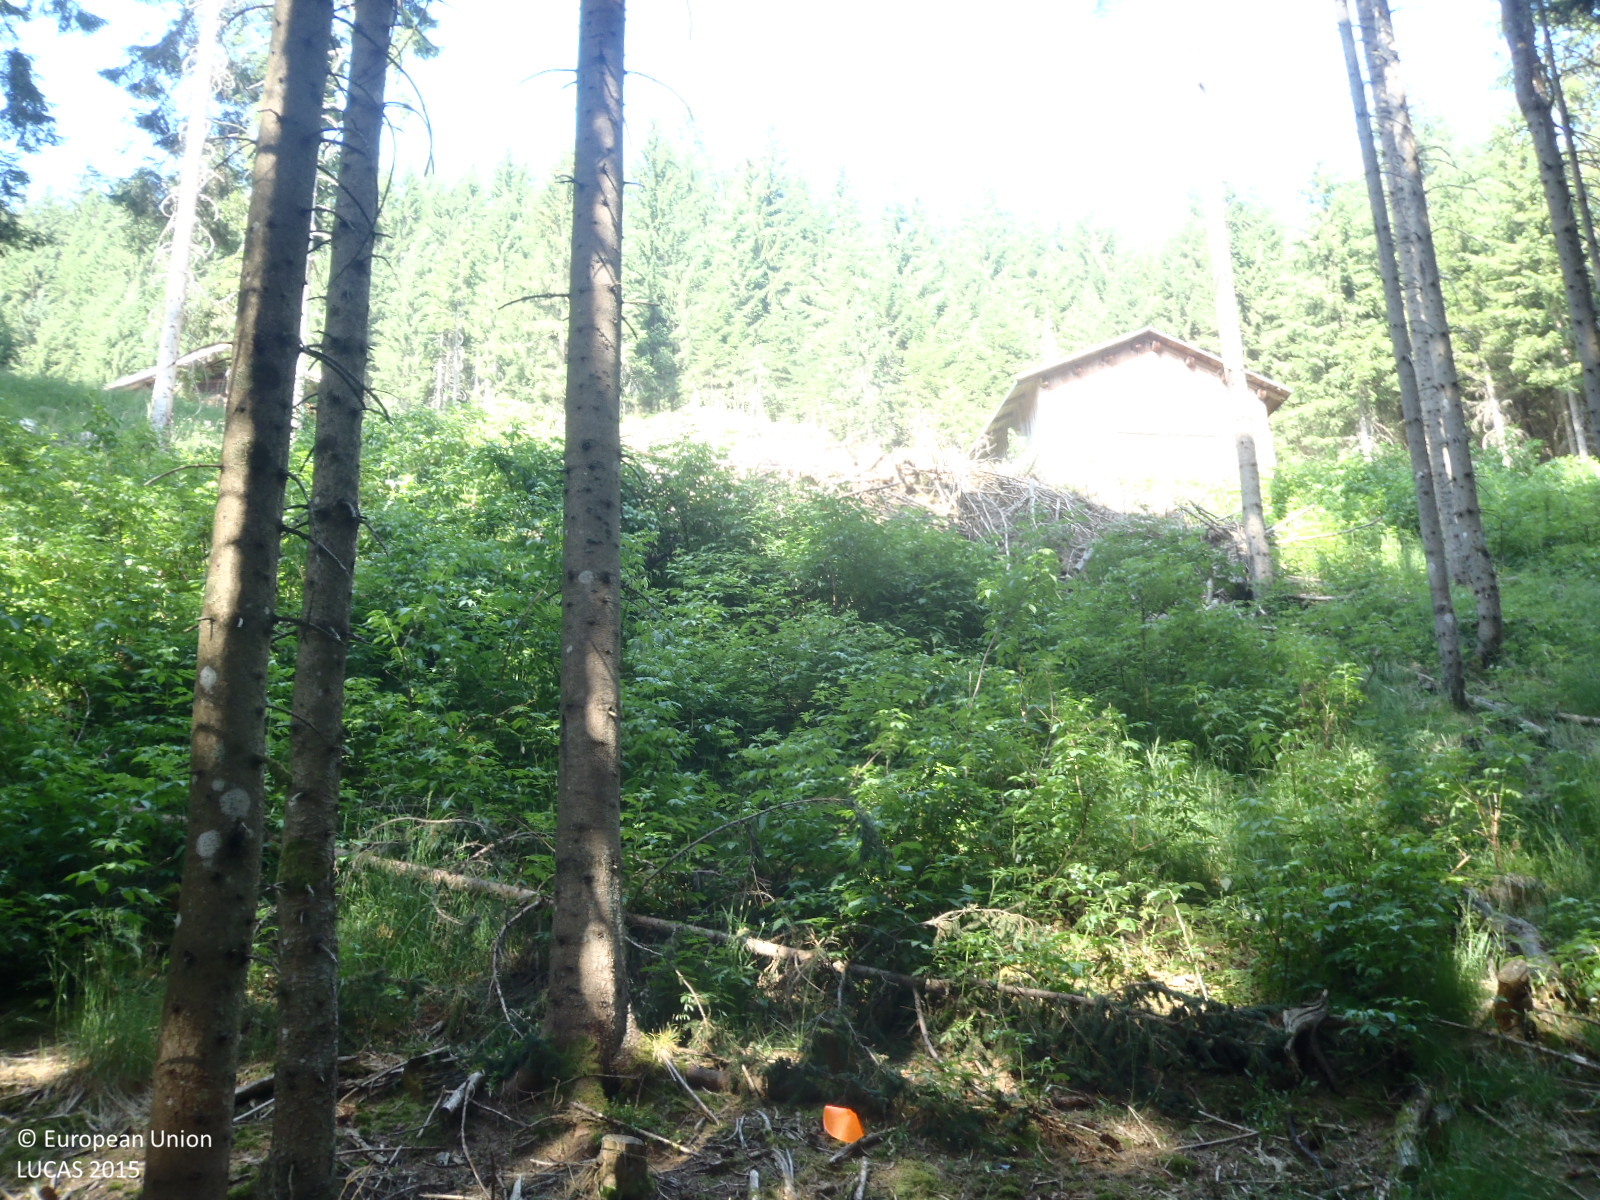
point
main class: Woodland
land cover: Spruce dominated coniferous woodland
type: alpine coniferous forest
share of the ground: > 75 %
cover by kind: coniferous forest trees 100 %
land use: Forestry
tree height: > 5 m
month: July
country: AT
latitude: 47.0895
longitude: 10.0132
